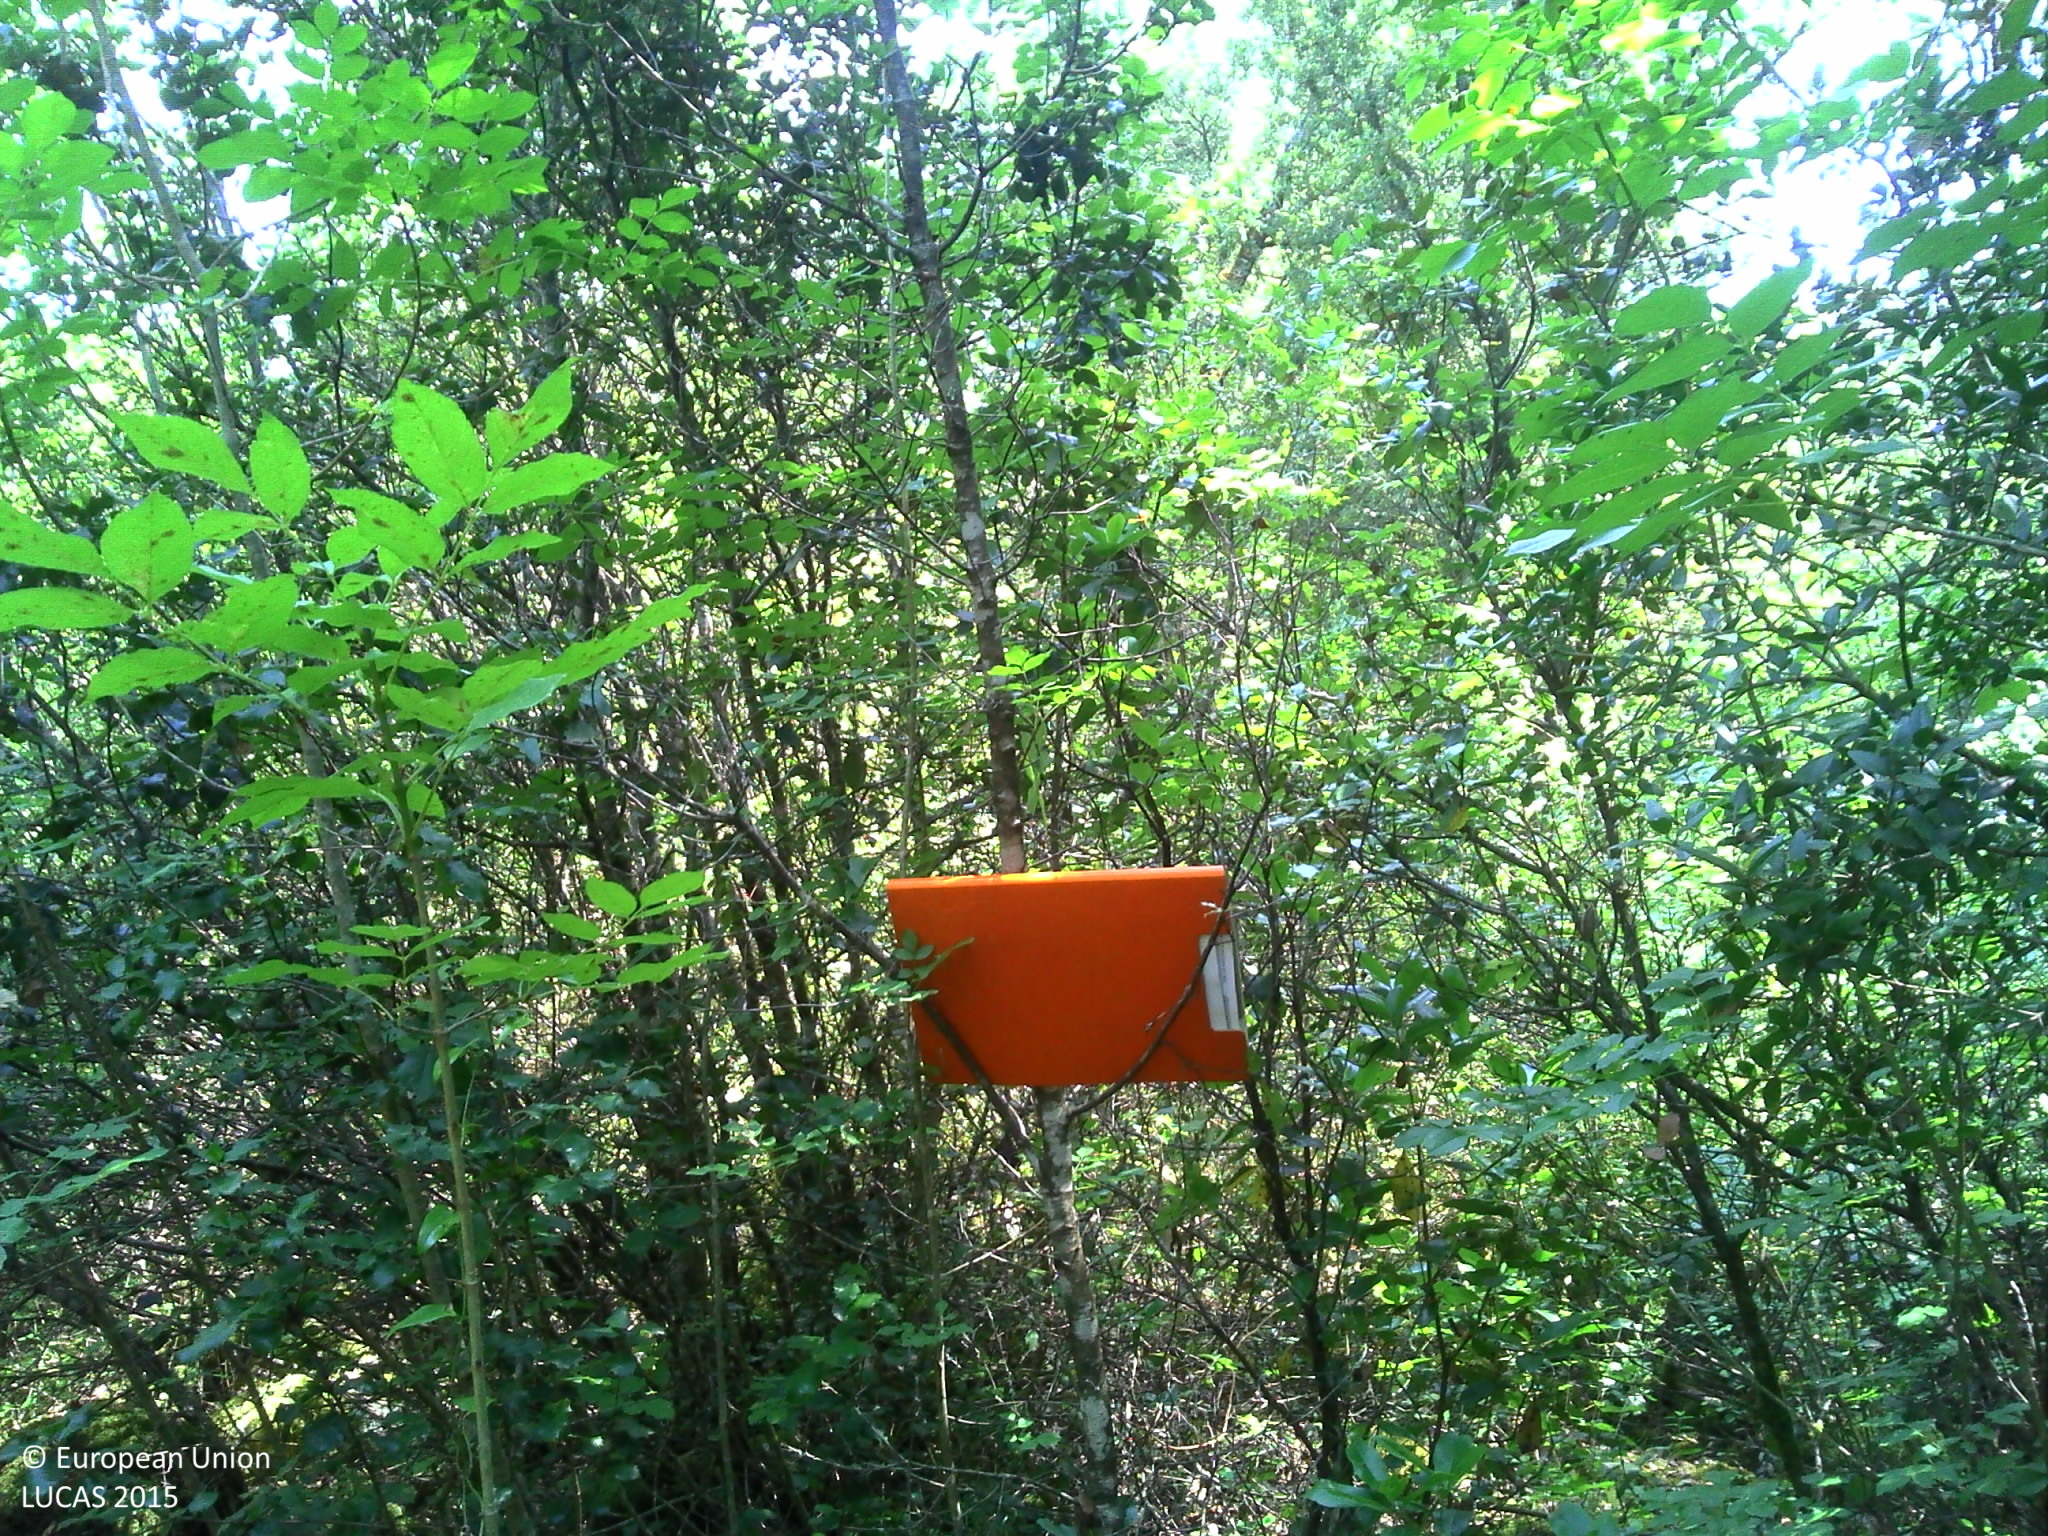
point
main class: Woodland
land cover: Broadleaved woodland
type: broadleaved evergreen forest
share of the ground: > 75 %
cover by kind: broadleaved forest trees 90 %, herbaceous plants 10 %
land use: Forestry
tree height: > 5 m
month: June
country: FR
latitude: 42.0895
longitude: 9.0485
